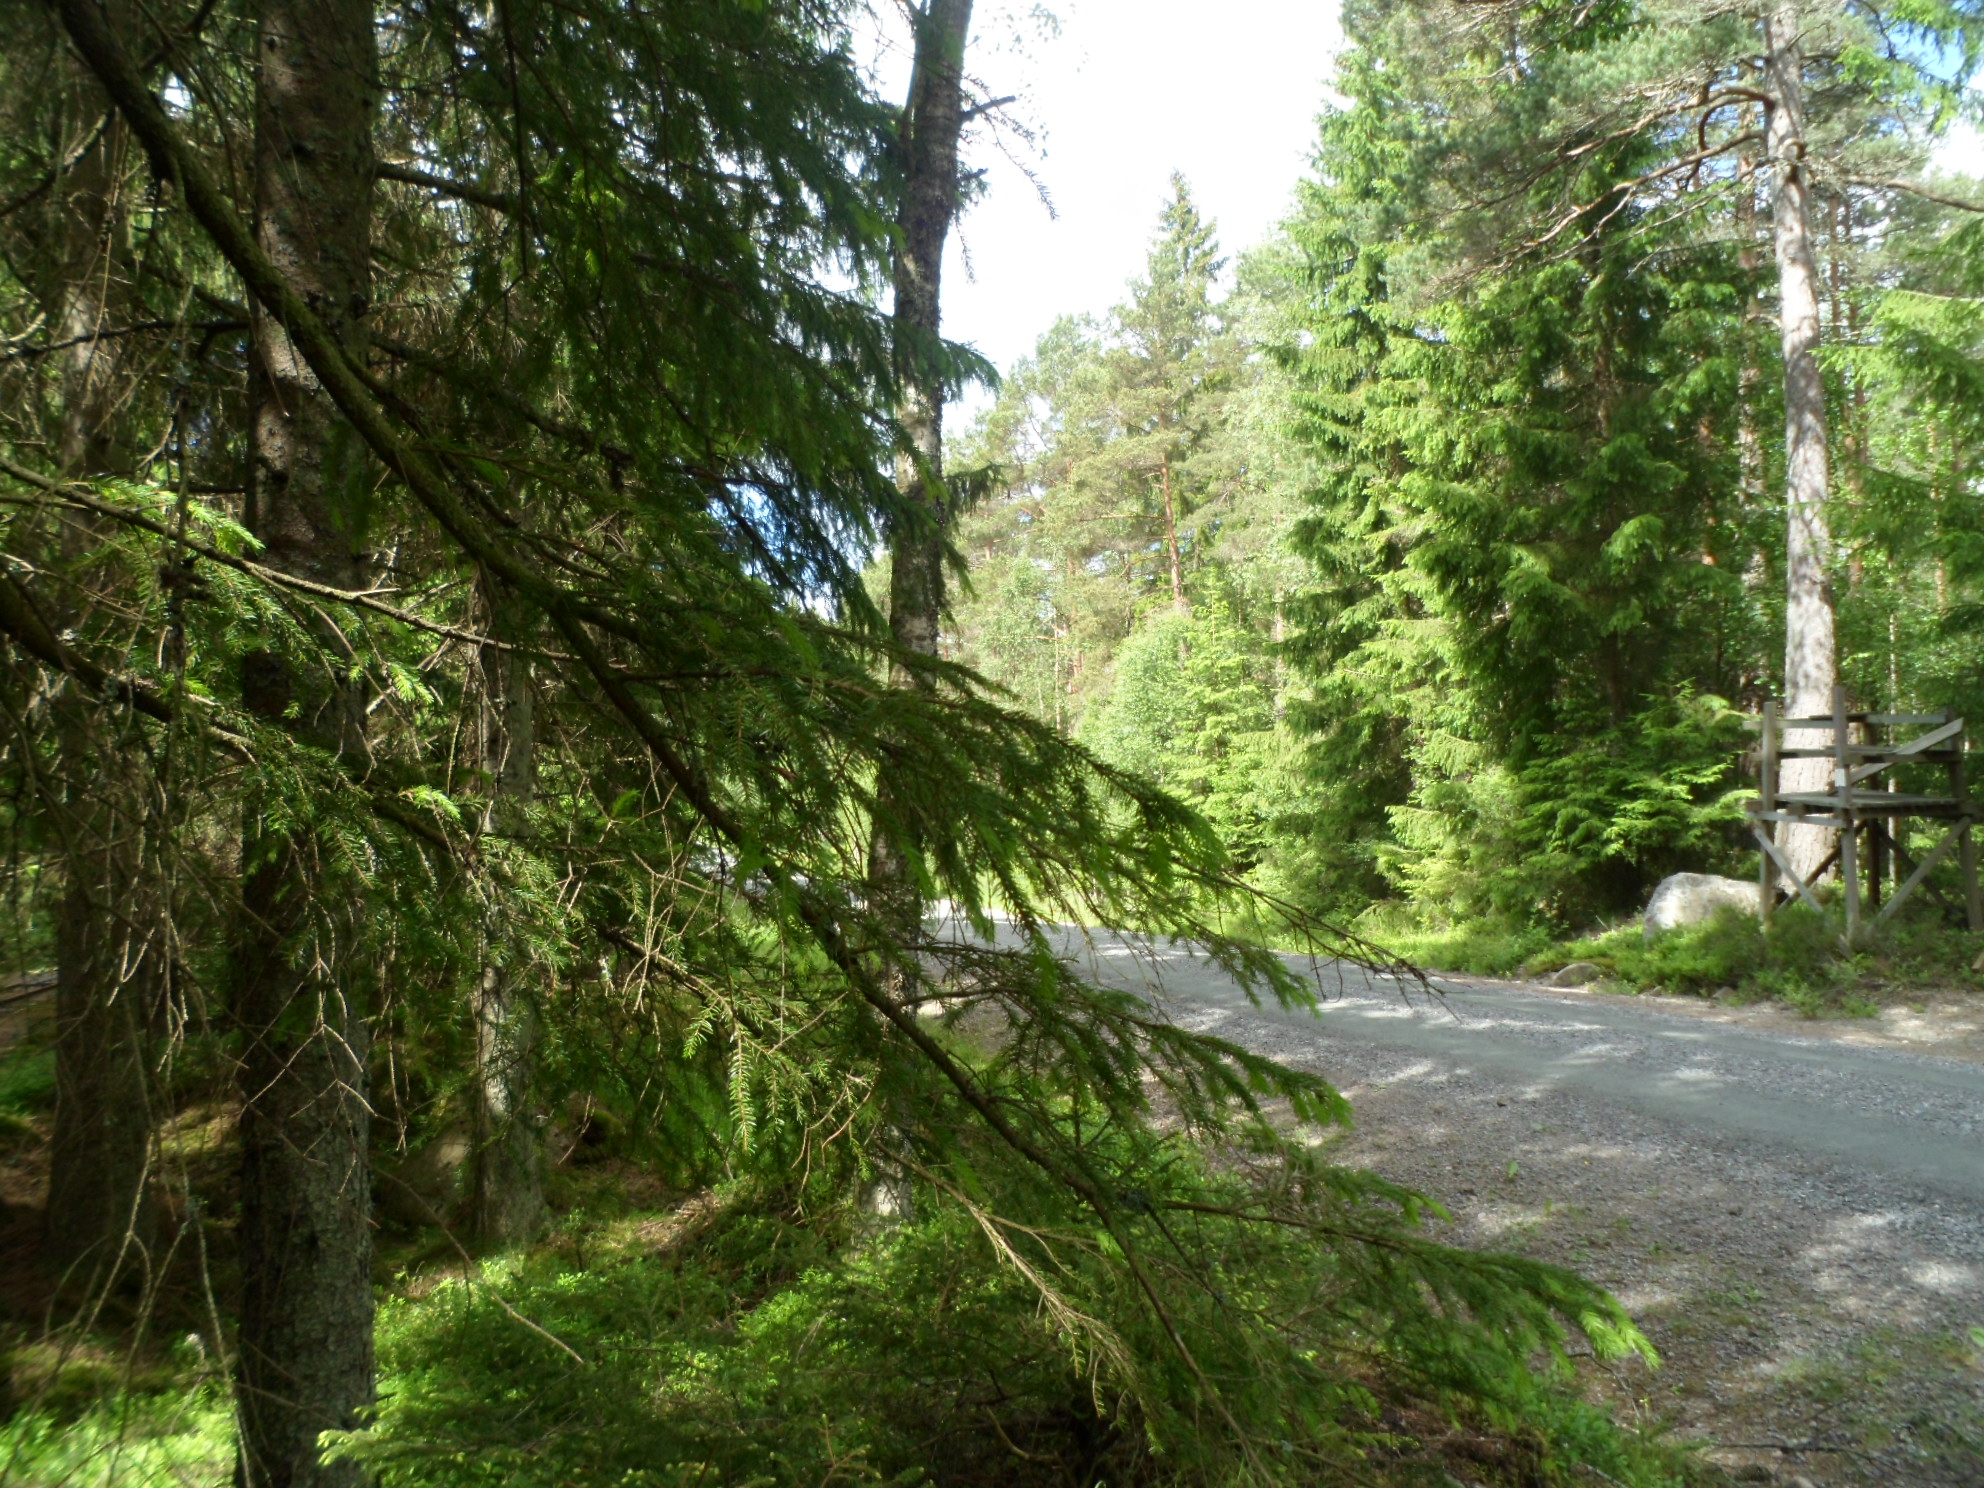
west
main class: Woodland
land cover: Spruce dominated coniferous woodland
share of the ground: 50 - 75 %
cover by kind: coniferous forest trees 60 %, lichens and mosses 15 %, shrubs 10 %, unconsolidated bare surface 10 %, herbaceous plants 5 %
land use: Forestry
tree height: > 5 m
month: June
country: SE
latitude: 57.1450
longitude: 14.2106
